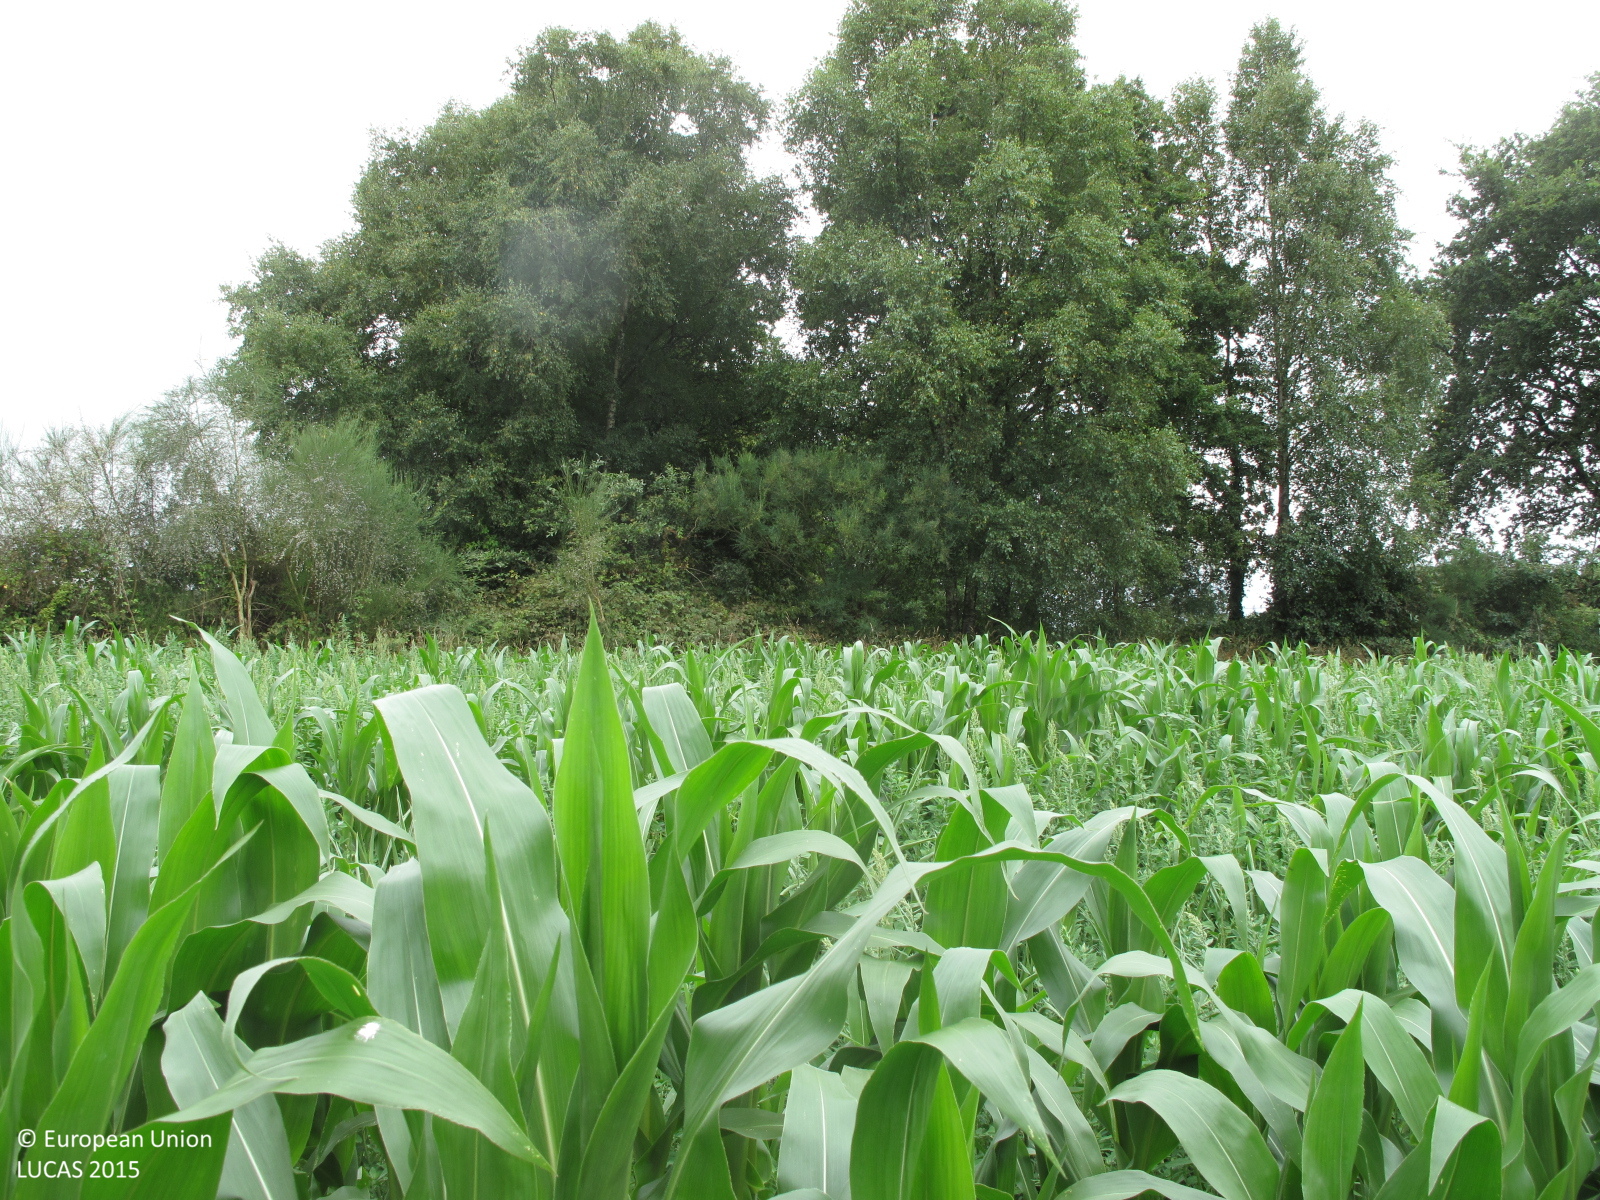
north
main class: Cropland
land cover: Maize
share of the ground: > 75 %
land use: Agriculture (excluding fallow land and kitchen gardens)
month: July
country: ES
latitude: 43.1380
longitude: -8.0552
